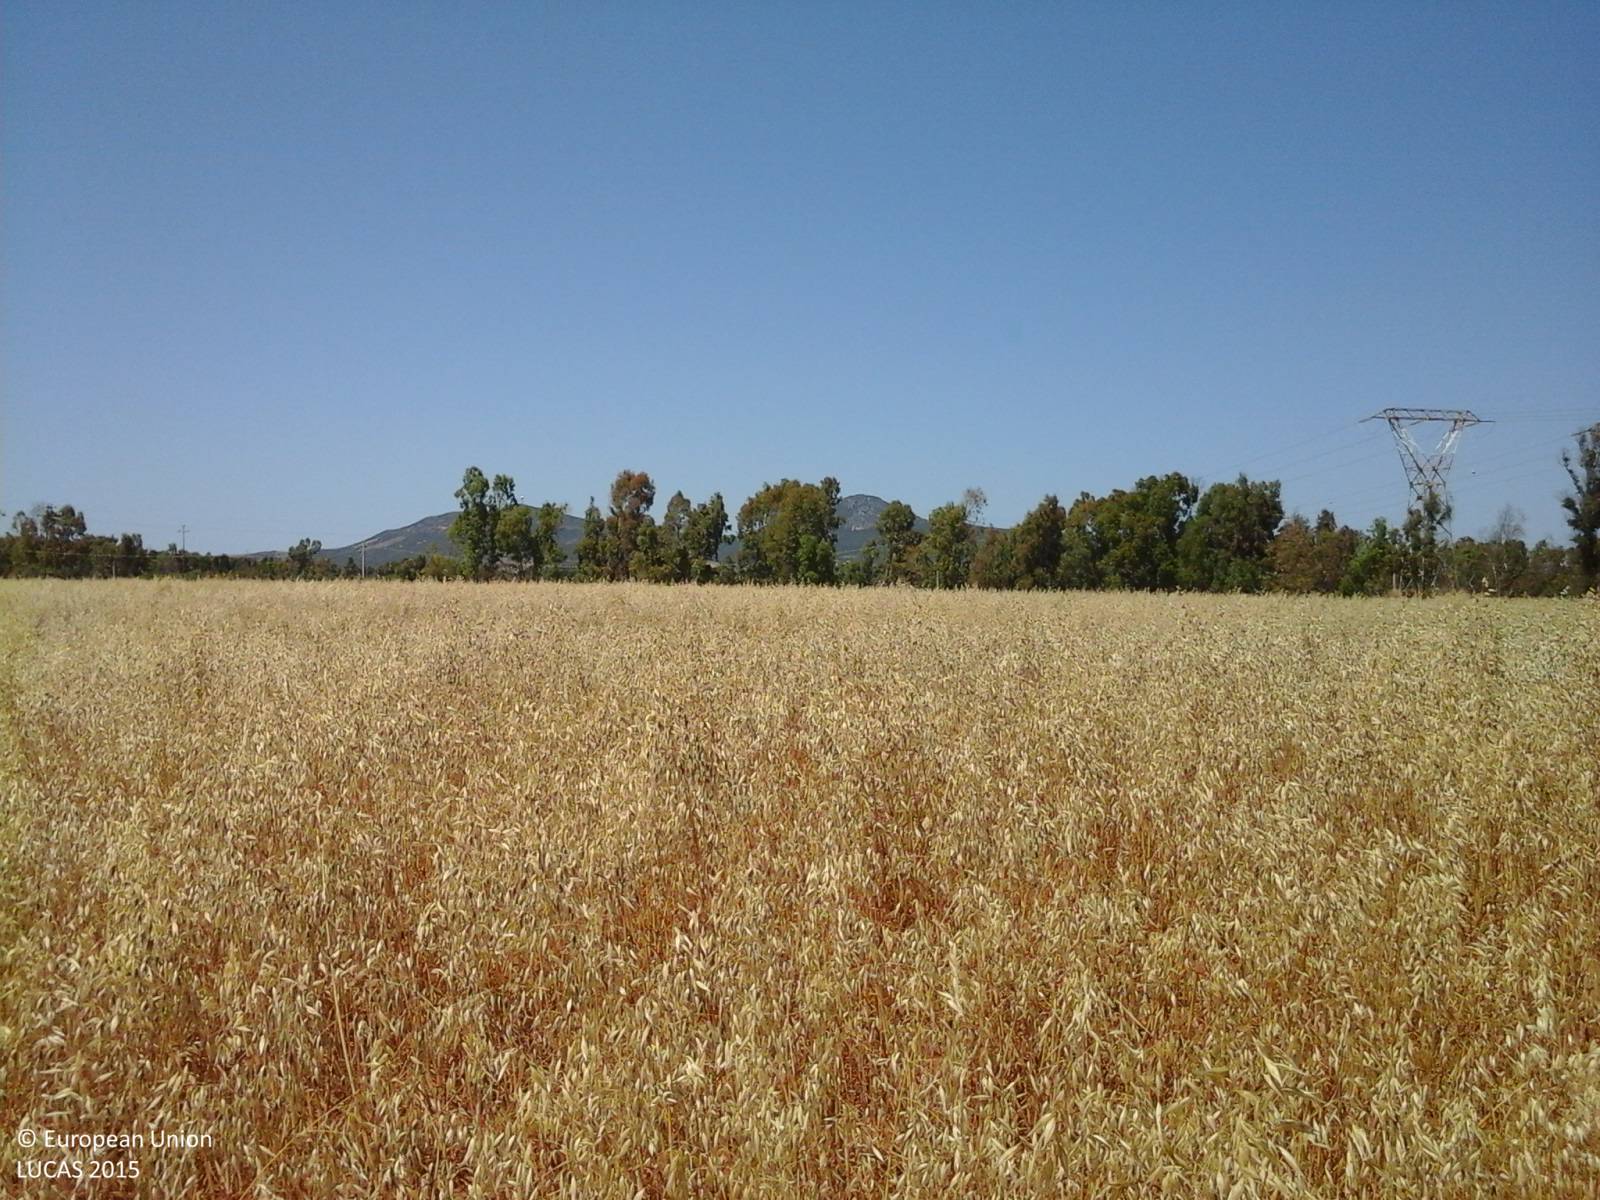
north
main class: Cropland
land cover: Oats
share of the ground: > 75 %
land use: Agriculture (excluding fallow land and kitchen gardens)
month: June
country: IT
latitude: 40.6680
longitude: 8.2459
